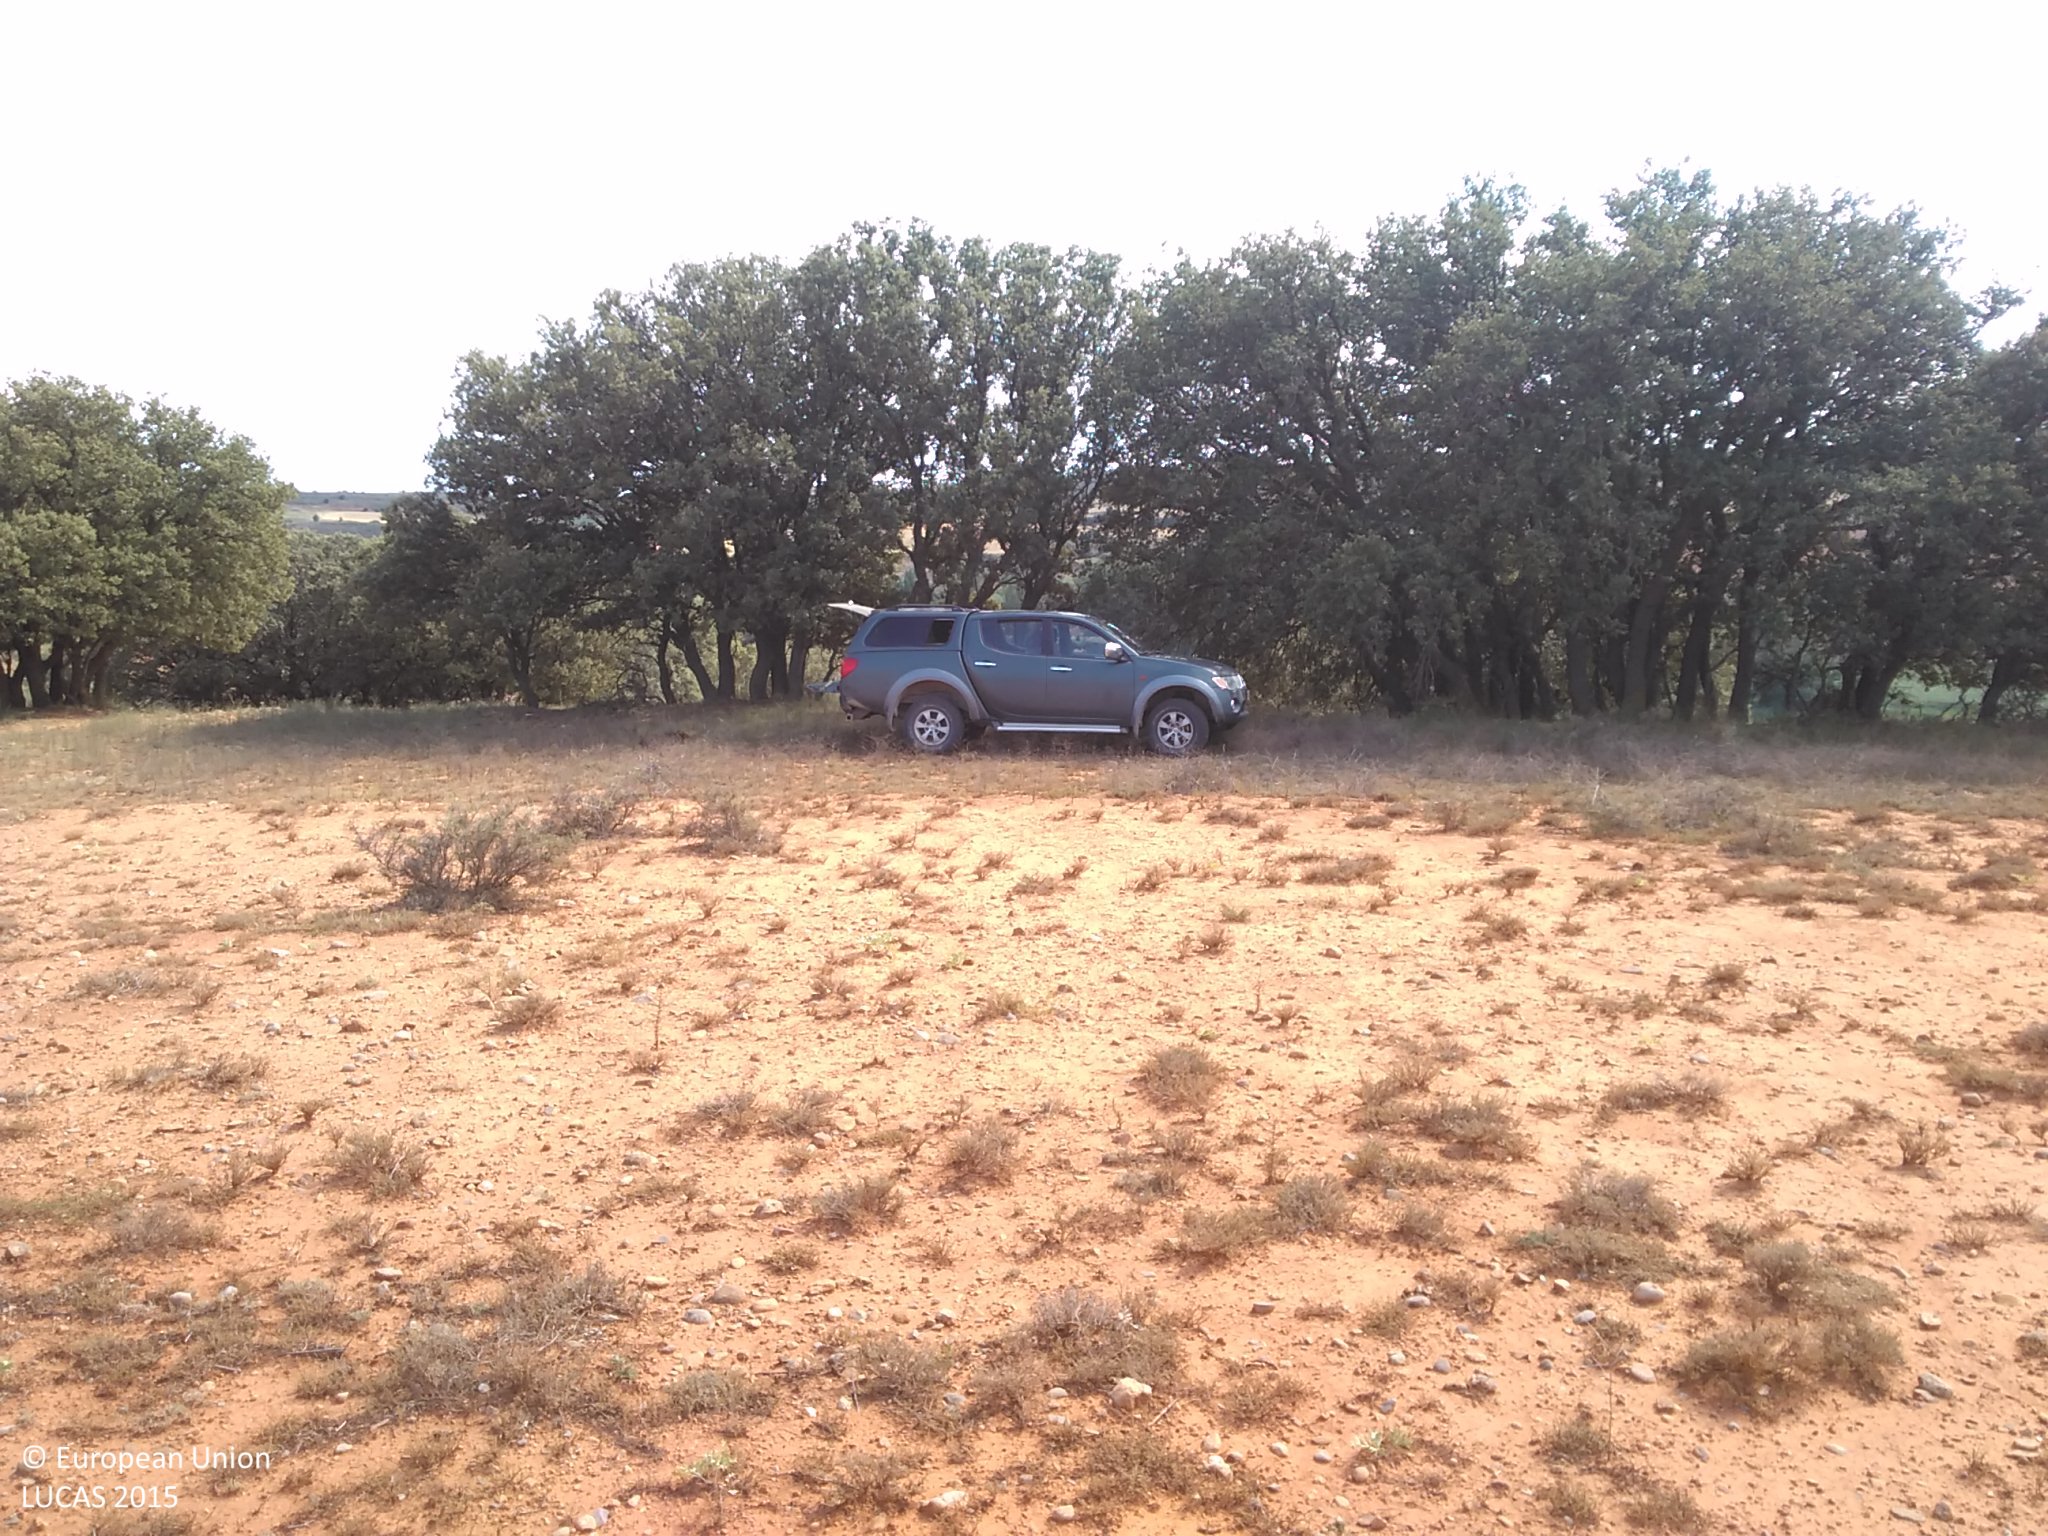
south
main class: Grassland
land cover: Spontaneously vegetated surfaces
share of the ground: 25 - 50 %
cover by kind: unconsolidated bare surface 50 %, herbaceous plants 45 %, shrubs 5 %
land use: Semi-natural and natural areas not in use
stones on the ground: < 10 %
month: July
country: ES
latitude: 41.5099
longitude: -2.2175
